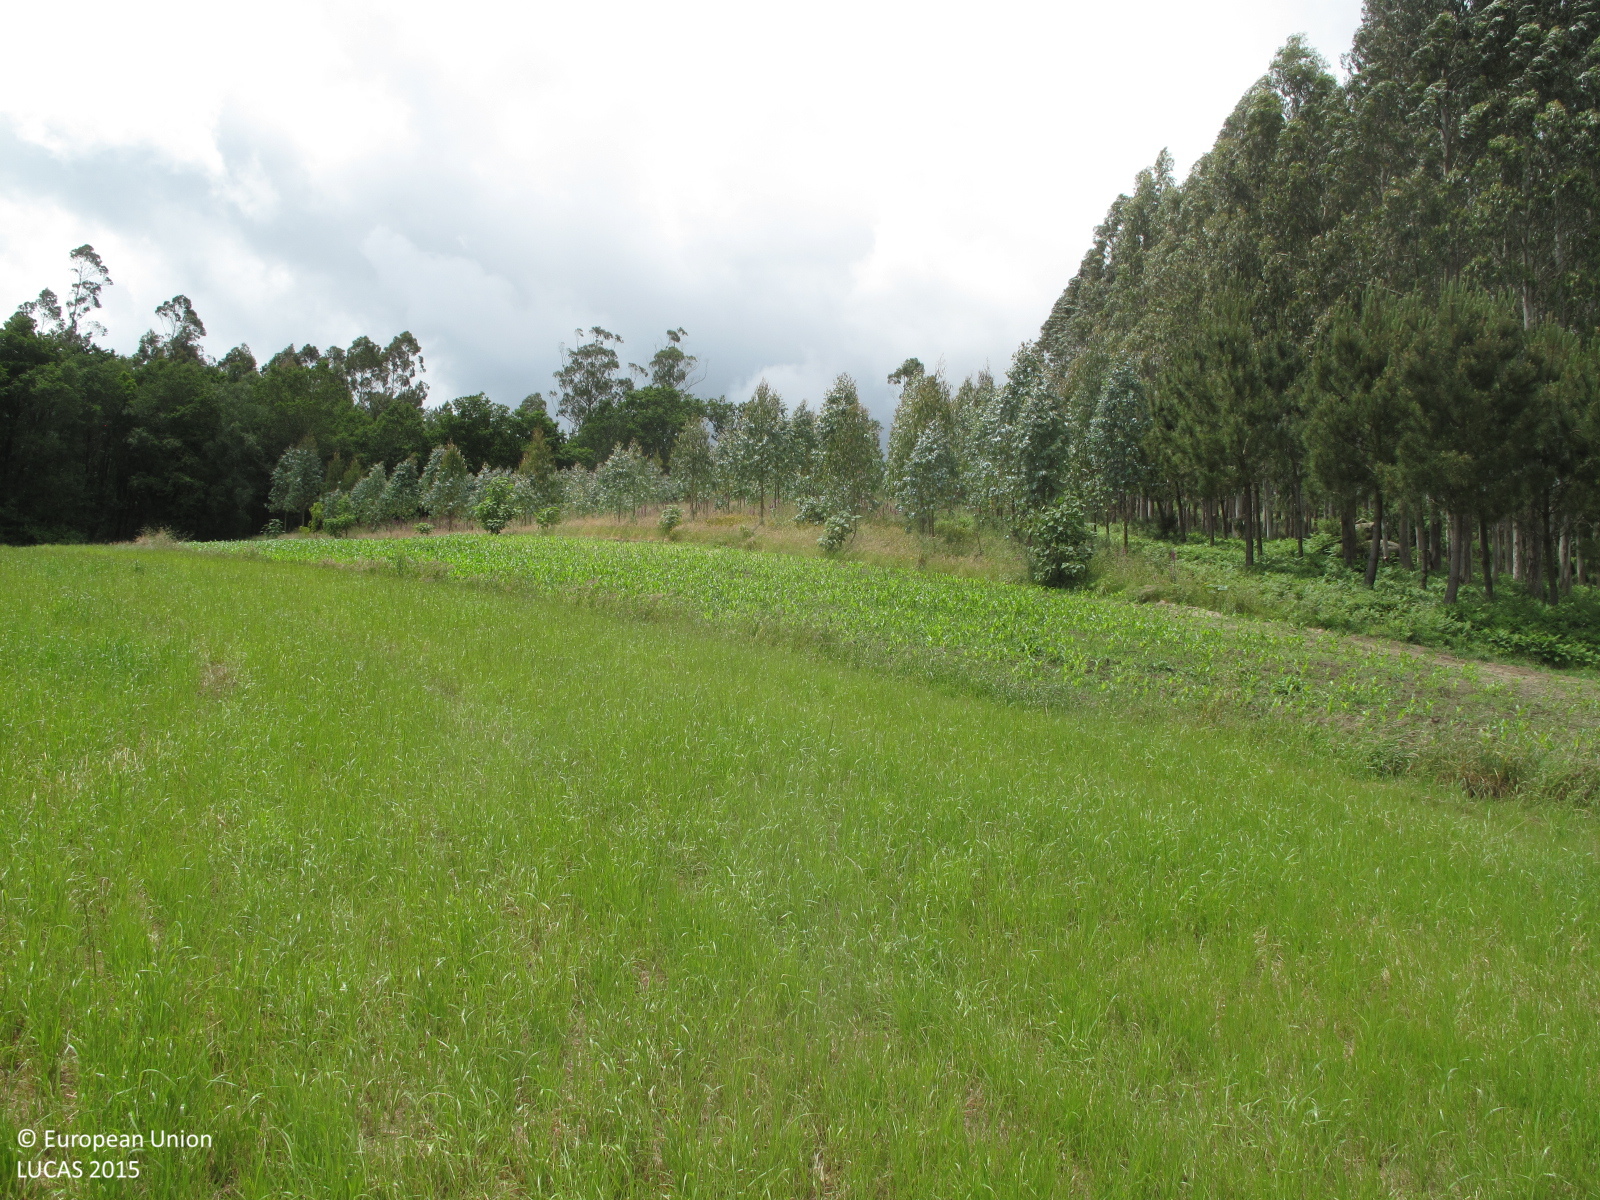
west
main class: Grassland
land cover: Grassland without tree/shrub cover
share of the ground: > 75 %
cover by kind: herbaceous plants 100 %
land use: Agriculture (excluding fallow land and kitchen gardens)
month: June
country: ES
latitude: 43.1073
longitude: -8.5272
